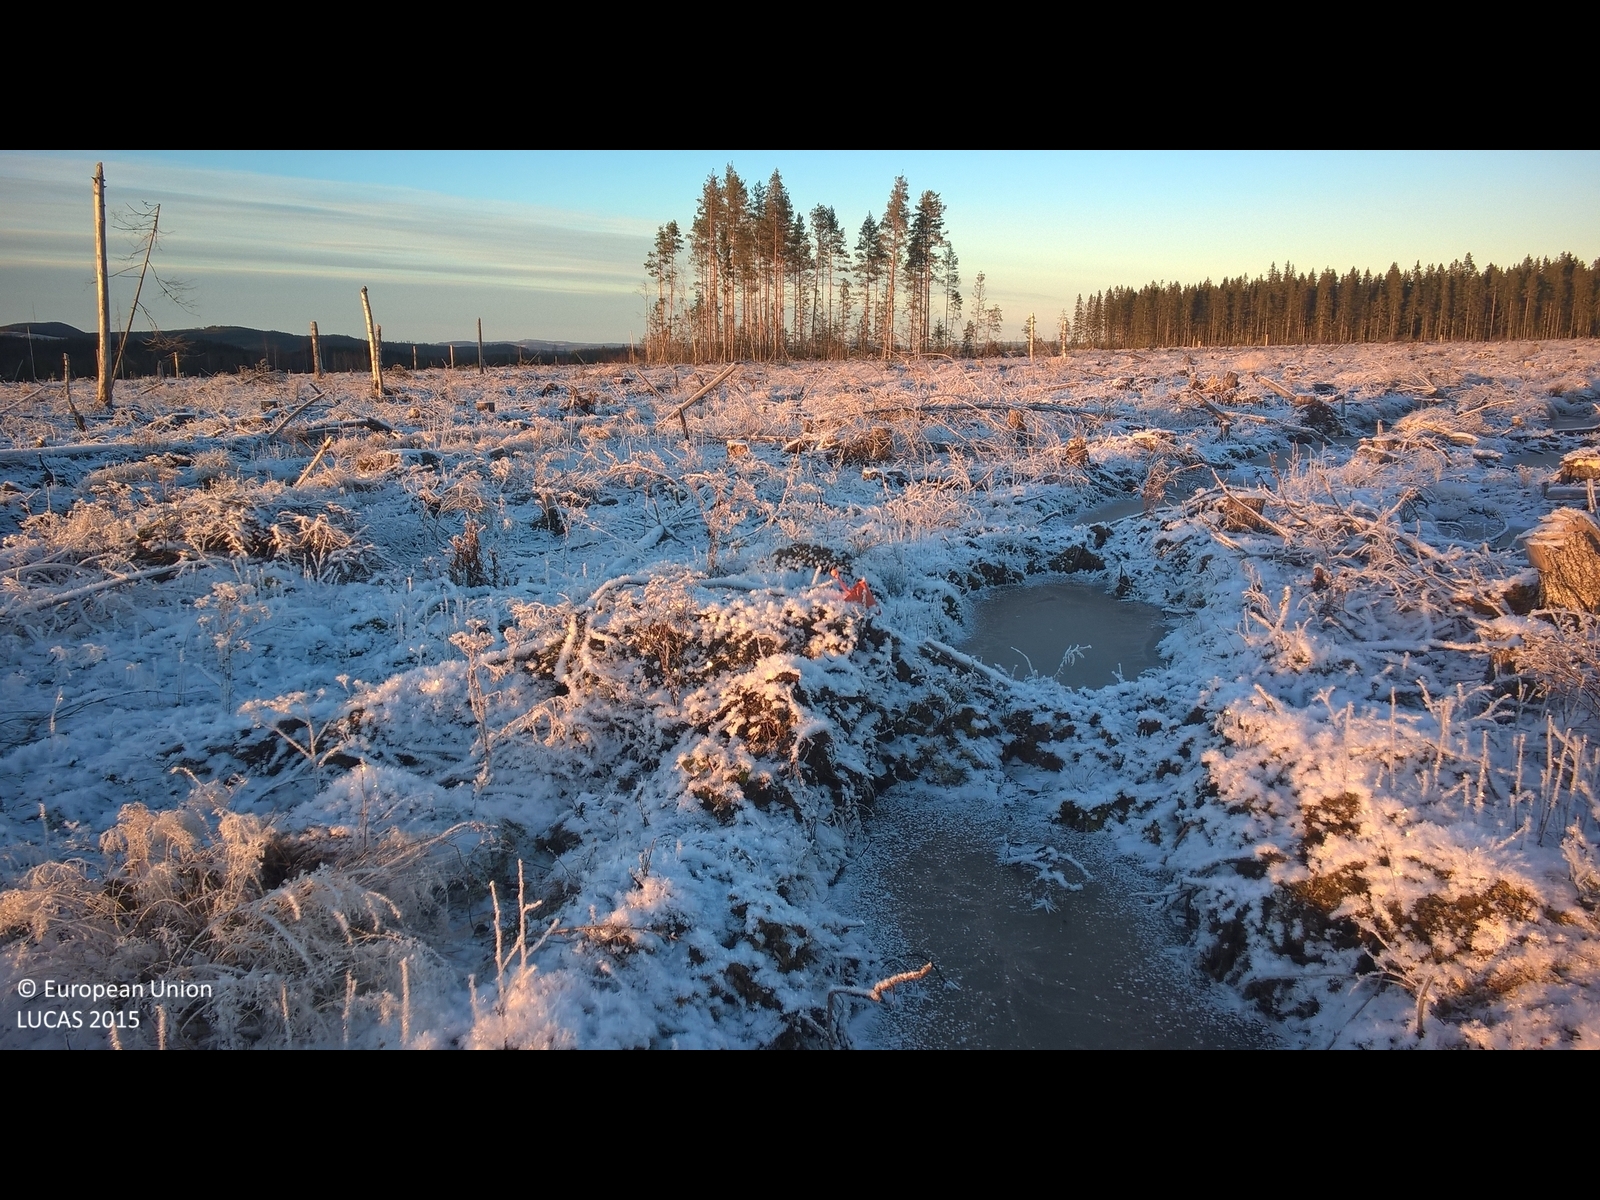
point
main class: Grassland
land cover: Grassland with sparse tree/shrub cover
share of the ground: 10 - 25 %
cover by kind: lichens and mosses 75 %, herbaceous plants 15 %, coniferous forest trees 5 %, shrubs 5 %
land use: Forestry
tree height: > 5 m
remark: Clear cut
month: November
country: SE
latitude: 60.3881
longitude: 14.2162
